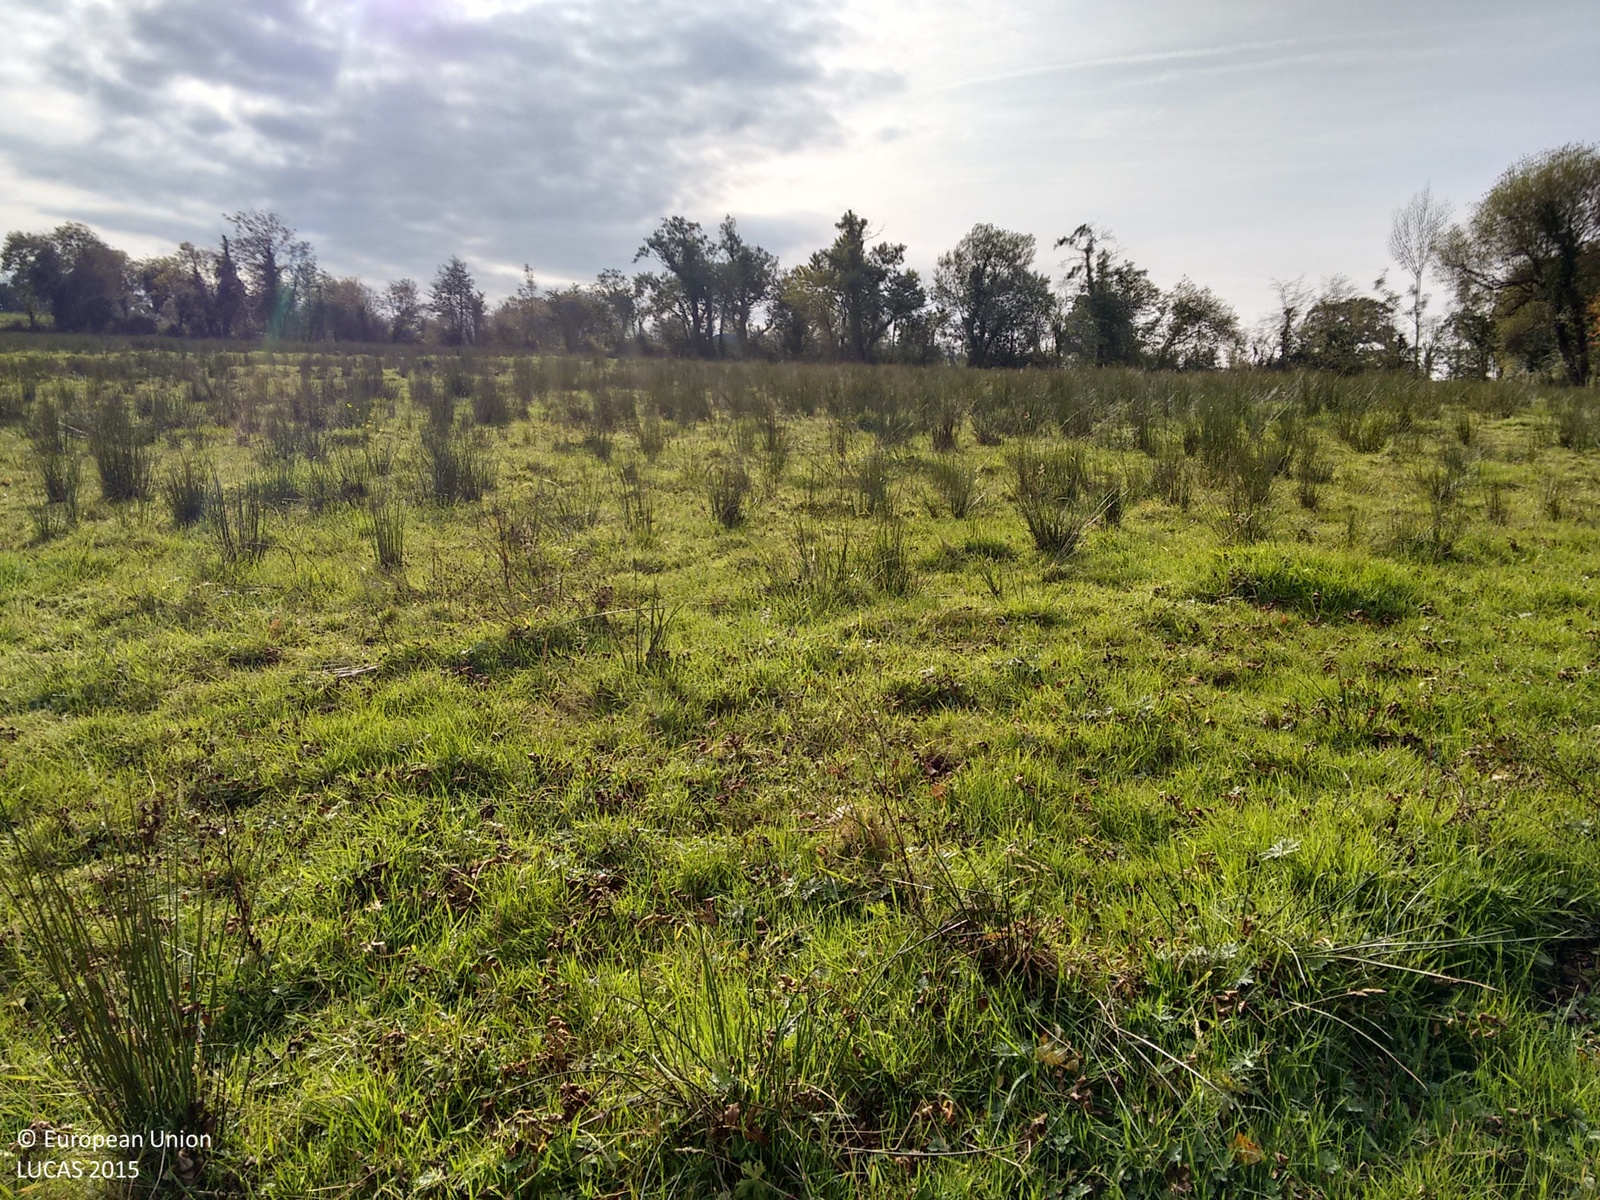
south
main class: Grassland
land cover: Grassland without tree/shrub cover
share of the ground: > 75 %
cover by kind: herbaceous plants 100 %
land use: Agriculture (excluding fallow land and kitchen gardens)
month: October
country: GB
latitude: 54.1403
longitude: -7.4998
